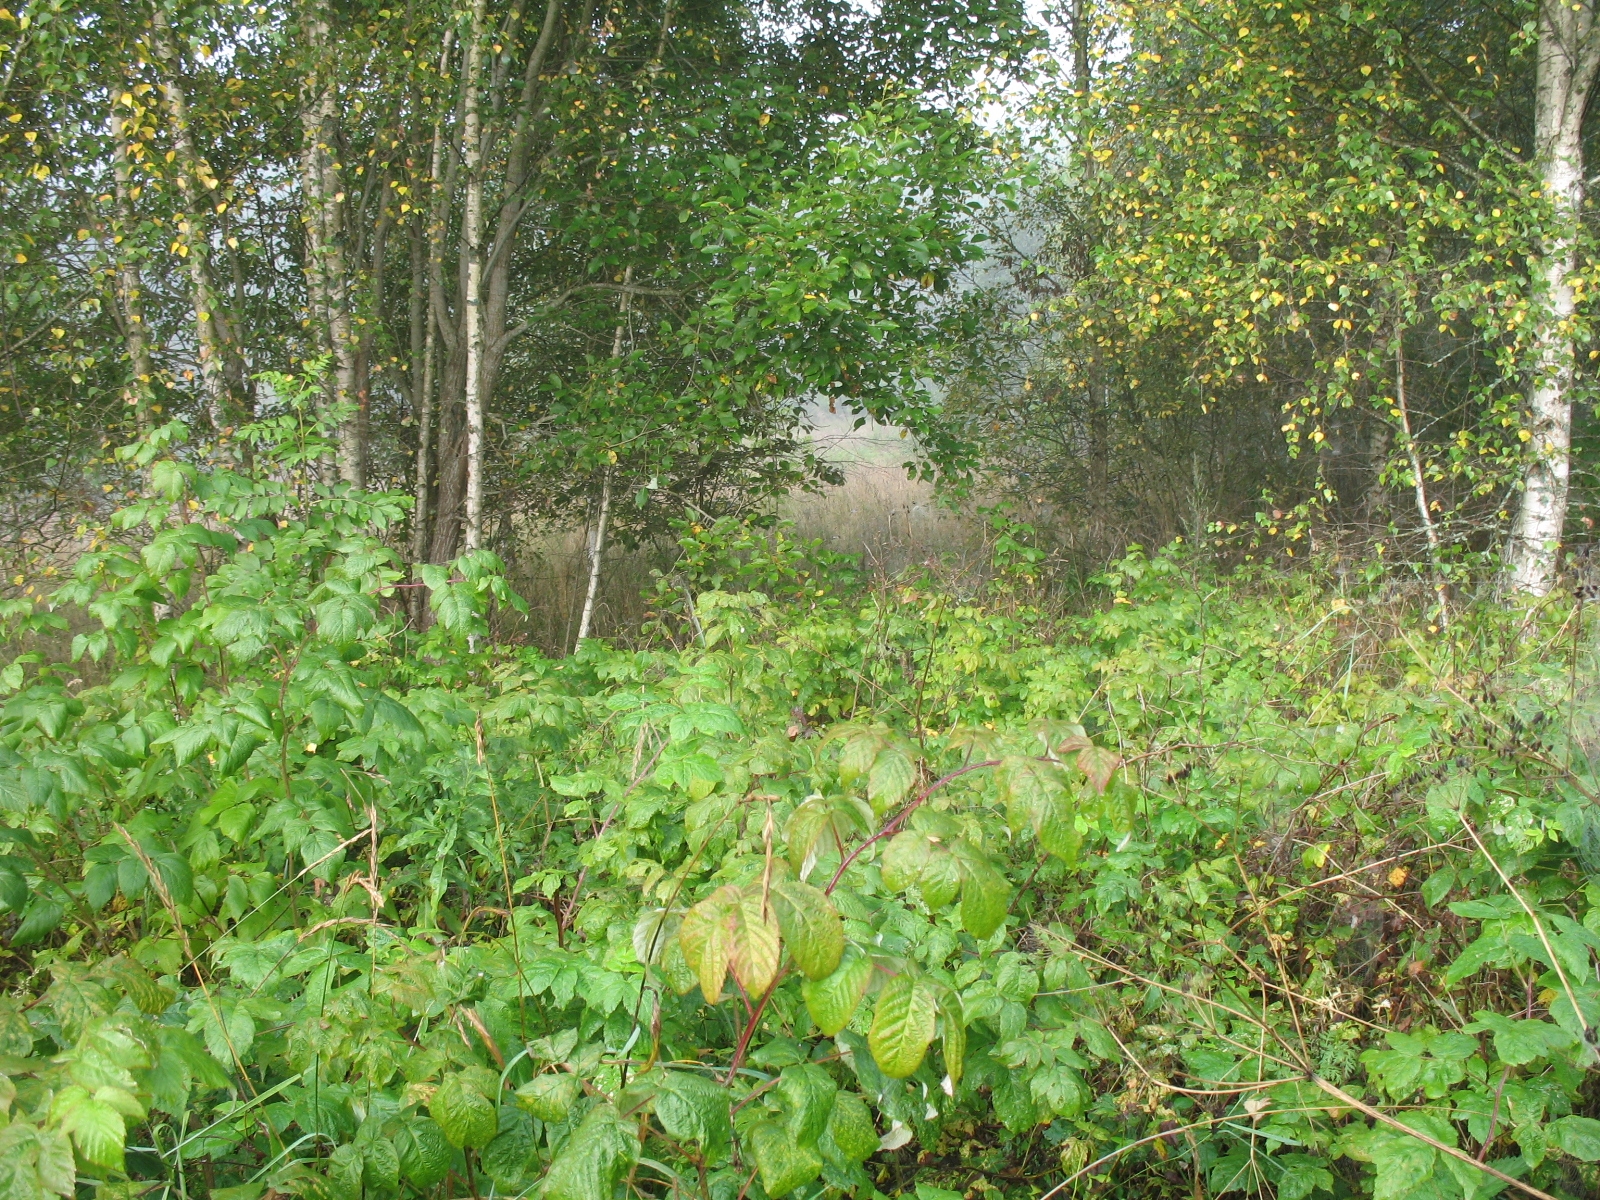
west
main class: Woodland
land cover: Broadleaved woodland
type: non-riverine alder, birch or aspen forest
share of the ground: 10 - 25 %
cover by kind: herbaceous plants 75 %, broadleaved forest trees 15 %, shrubs 10 %
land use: Forestry
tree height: > 5 m
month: September
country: LV
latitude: 56.1412
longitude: 26.0532
